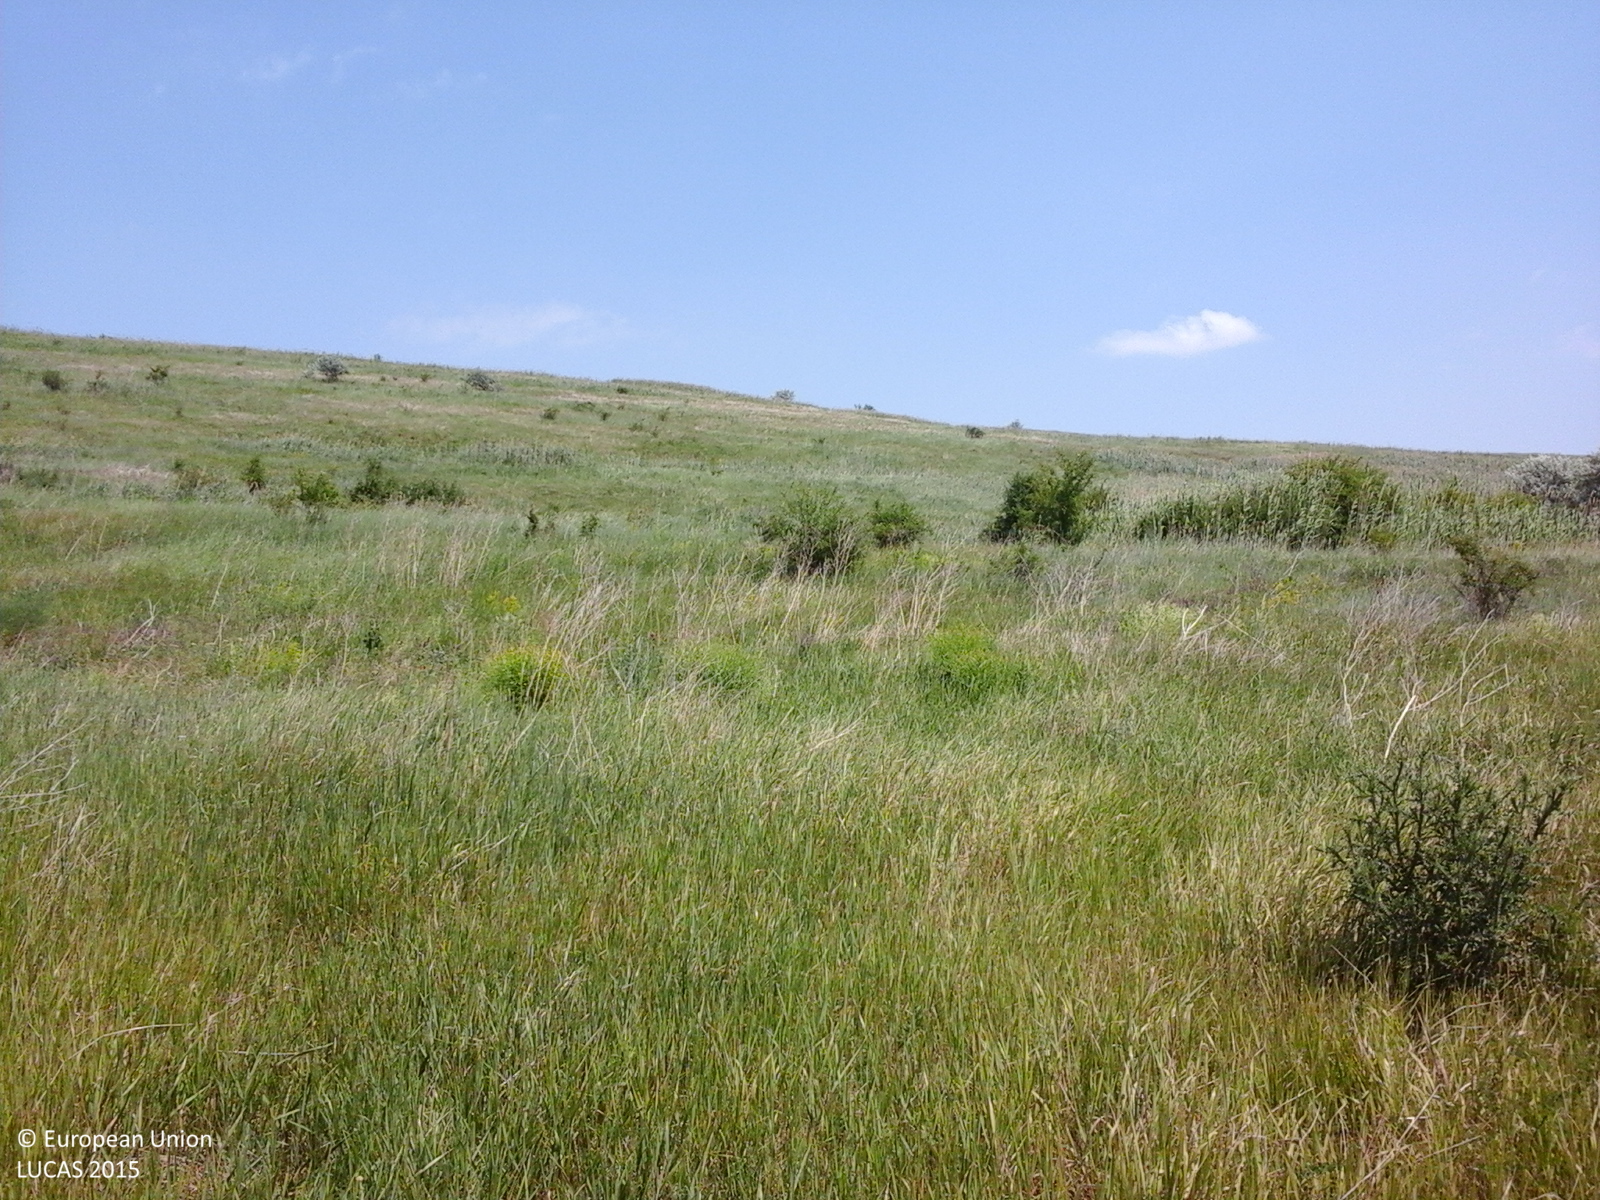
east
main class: Grassland
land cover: Grassland with sparse tree/shrub cover
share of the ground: > 75 %
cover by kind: herbaceous plants 90 %, broadleaved forest trees 5 %, shrubs 5 %
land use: Agriculture (excluding fallow land and kitchen gardens)
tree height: < 5 m
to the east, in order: Grassland with sparse tree/shrub cover; Grassland without tree/shrub cover
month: June
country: RO
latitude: 47.2441
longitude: 27.6526
